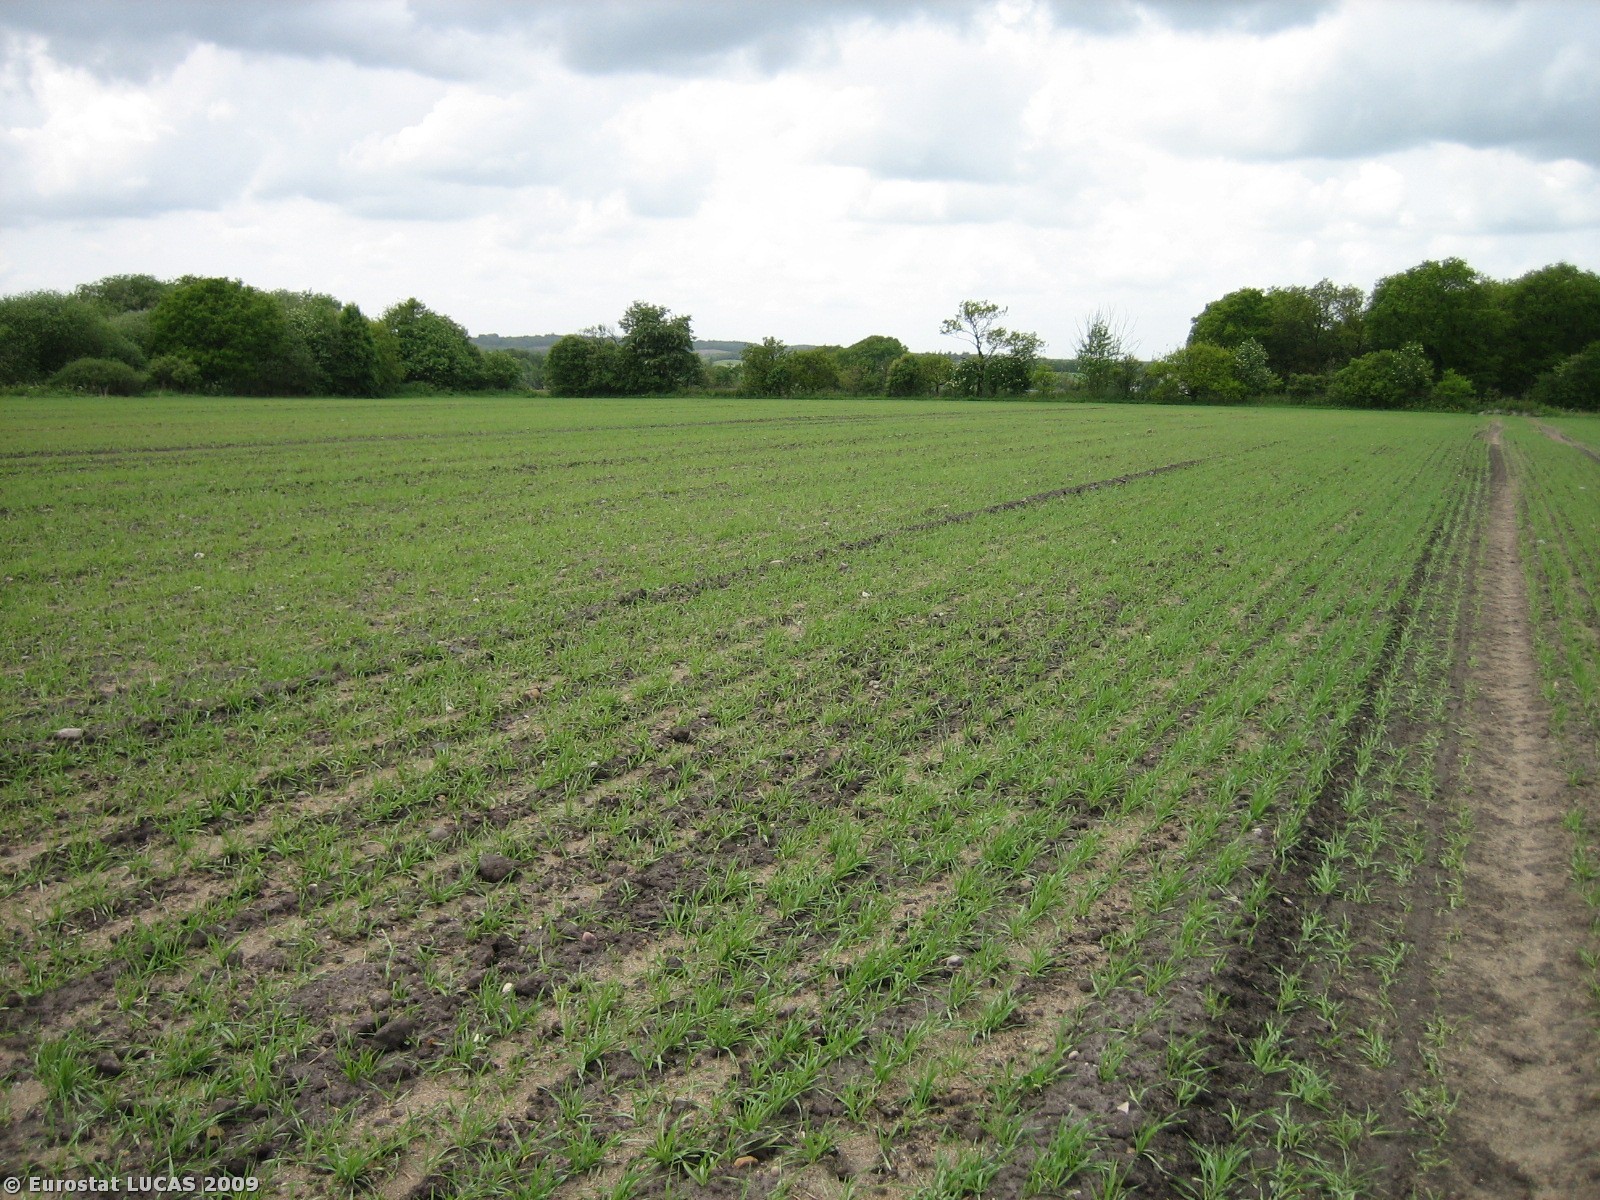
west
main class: Cropland
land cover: Barley
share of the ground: 50 - 75 %
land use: Agriculture (excluding fallow land and kitchen gardens)
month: May
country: DK
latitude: 56.1829
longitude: 8.8896
